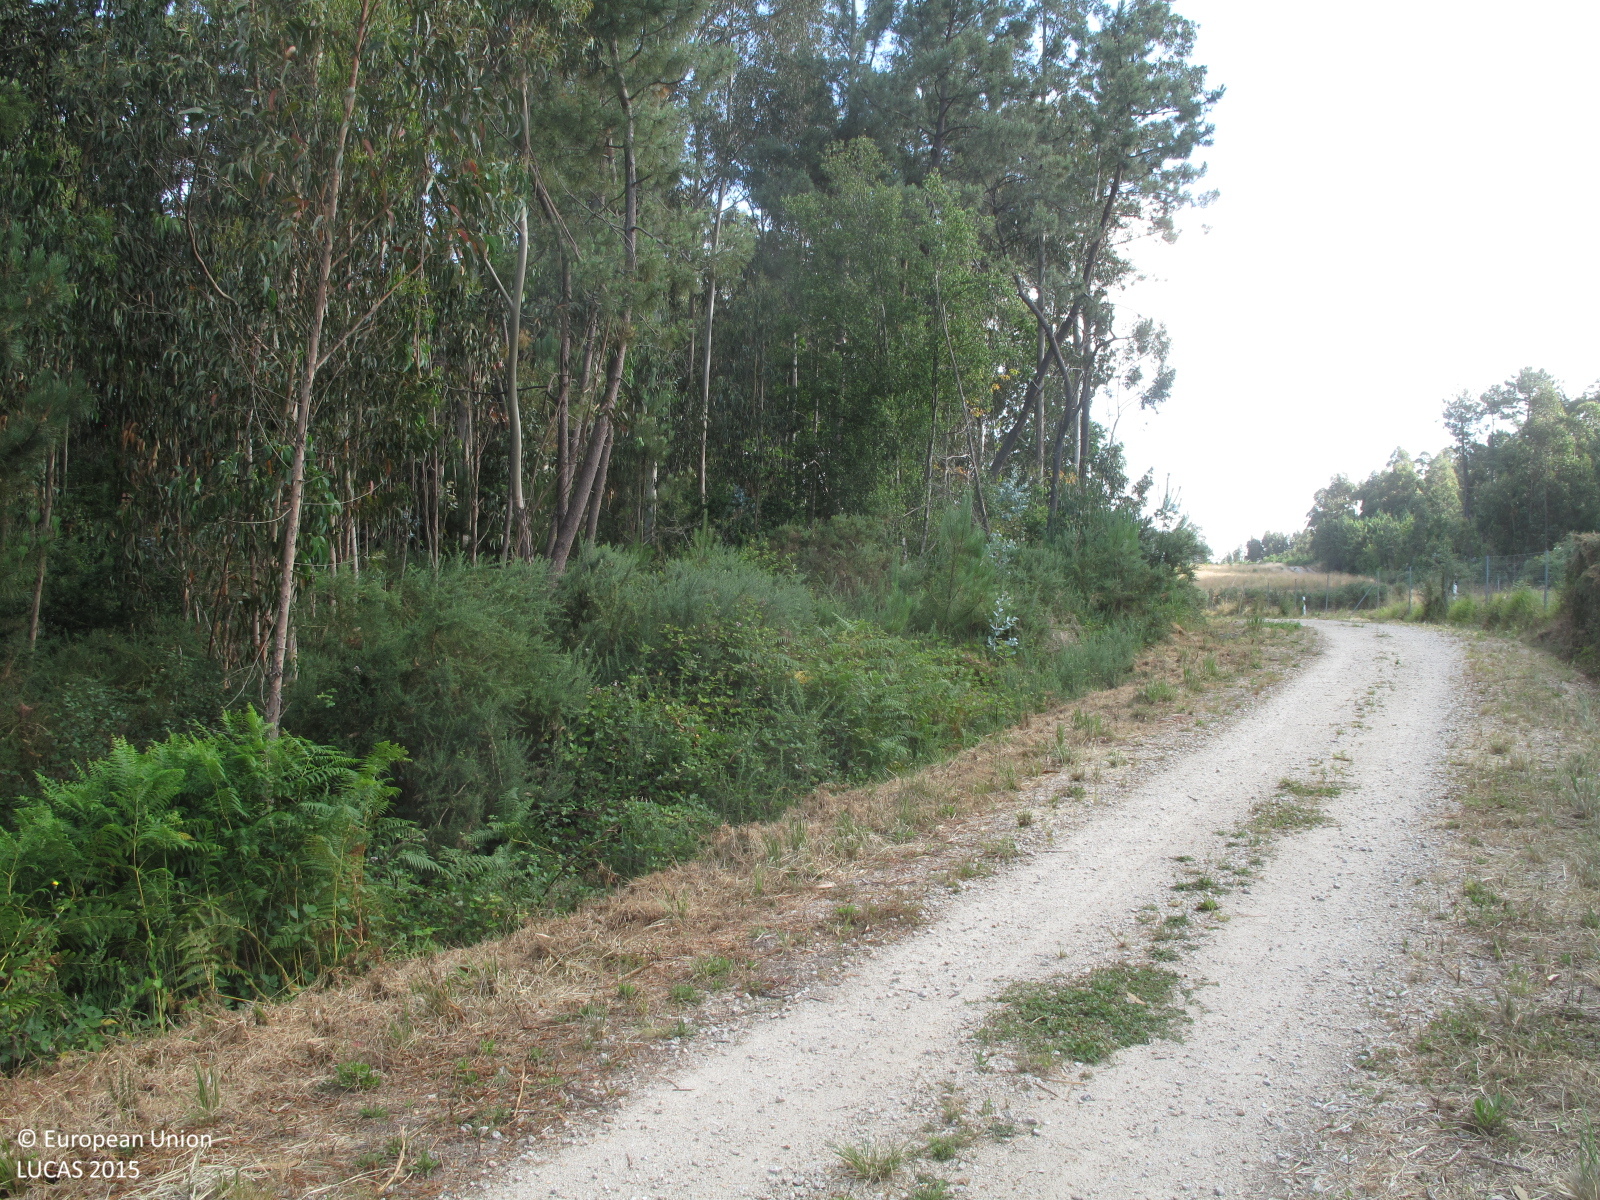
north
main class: Shrubland
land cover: Shrubland without tree cover
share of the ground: 50 - 75 %
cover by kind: shrubs 60 %, herbaceous plants 40 %
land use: Road transport
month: July
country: ES
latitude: 43.3693
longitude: -8.3066
